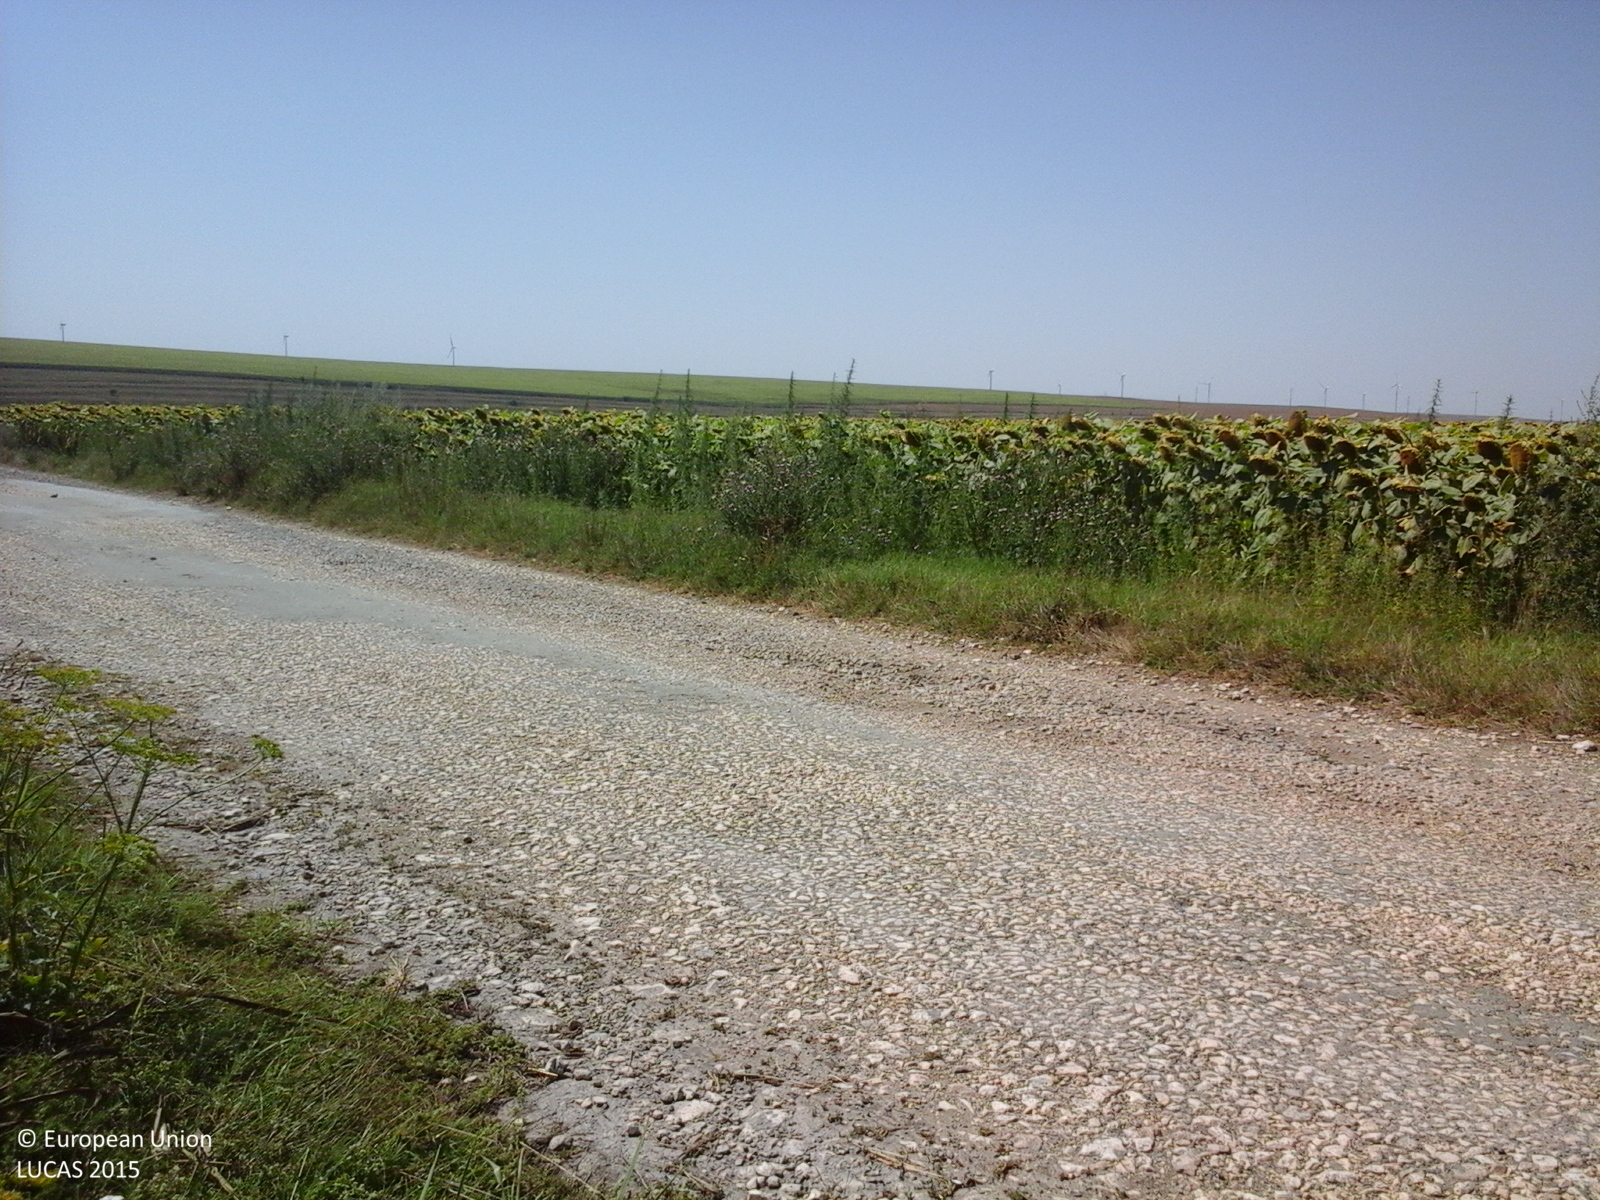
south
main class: Cropland
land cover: Maize
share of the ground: > 75 %
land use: Agriculture (excluding fallow land and kitchen gardens)
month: August
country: RO
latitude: 44.4373
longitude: 28.2177
